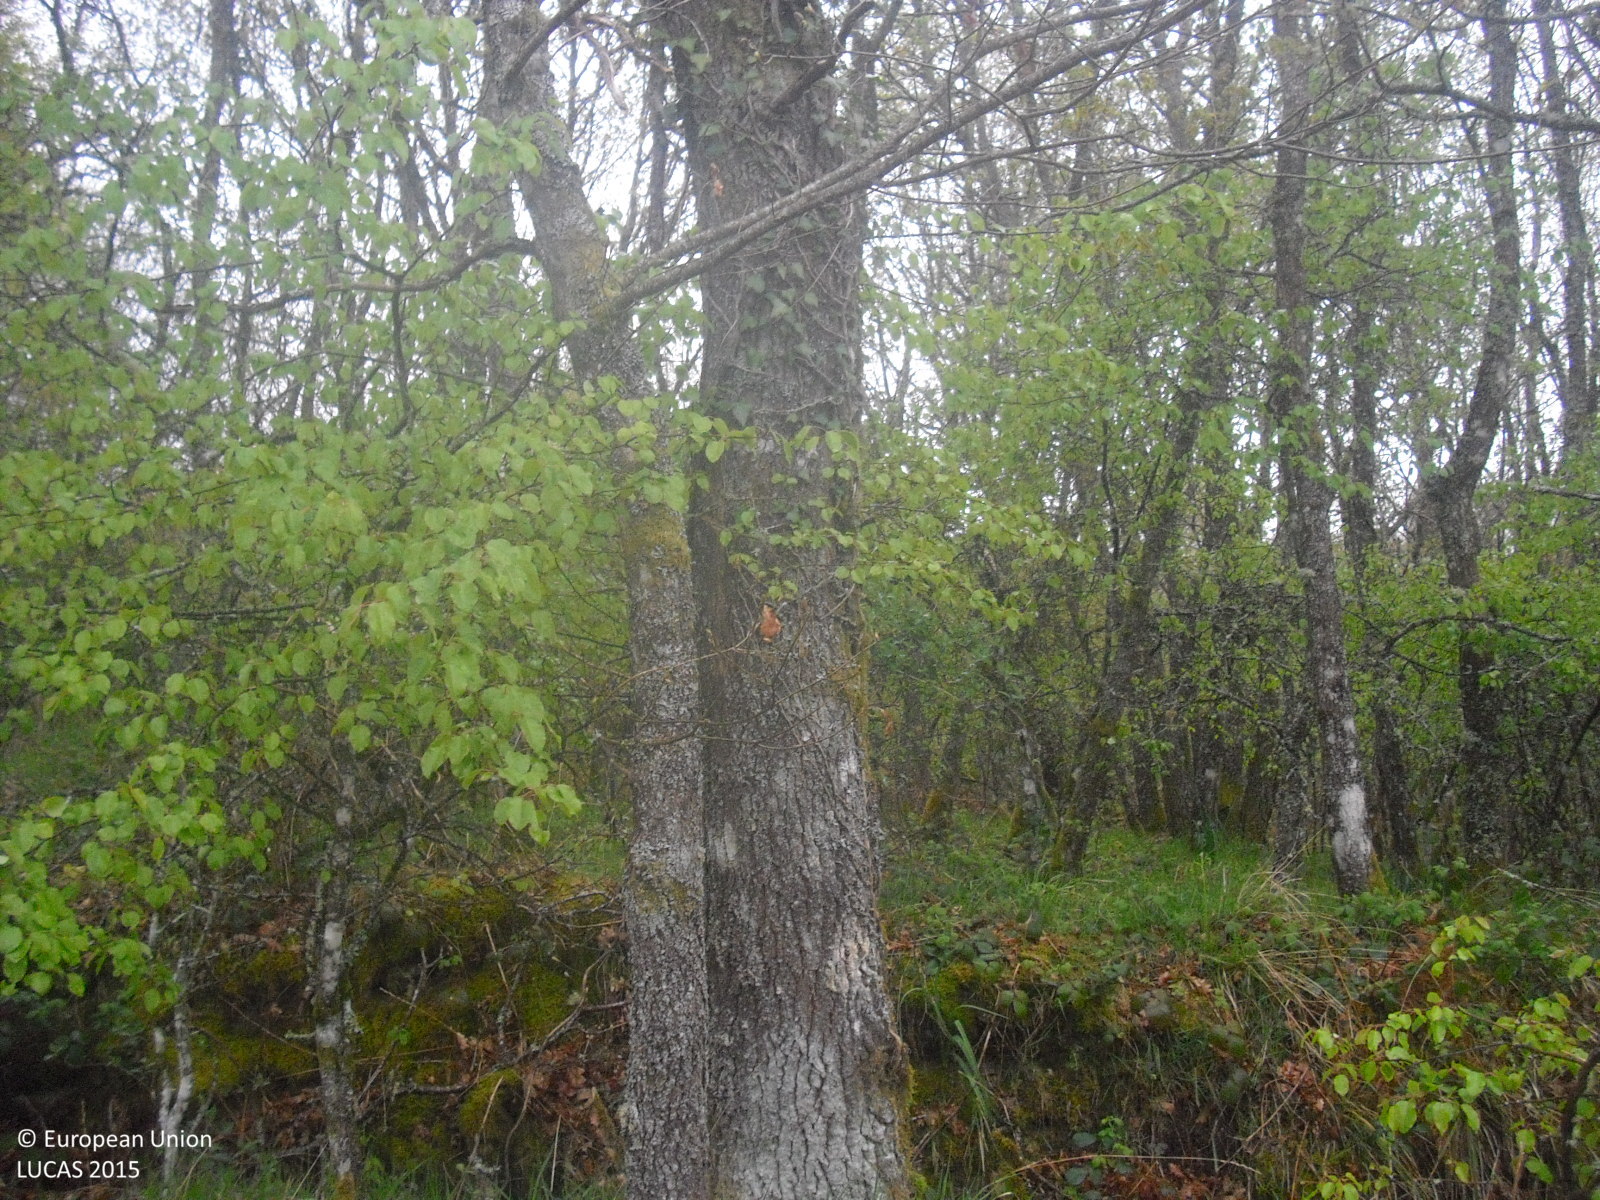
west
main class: Woodland
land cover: Broadleaved woodland
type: thermophilous deciduous forest
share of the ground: > 75 %
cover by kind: broadleaved forest trees 70 %, herbaceous plants 20 %, shrubs 10 %
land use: Forestry
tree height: > 5 m
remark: Clear cut
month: April
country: ES
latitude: 42.0768
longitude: -7.9034
